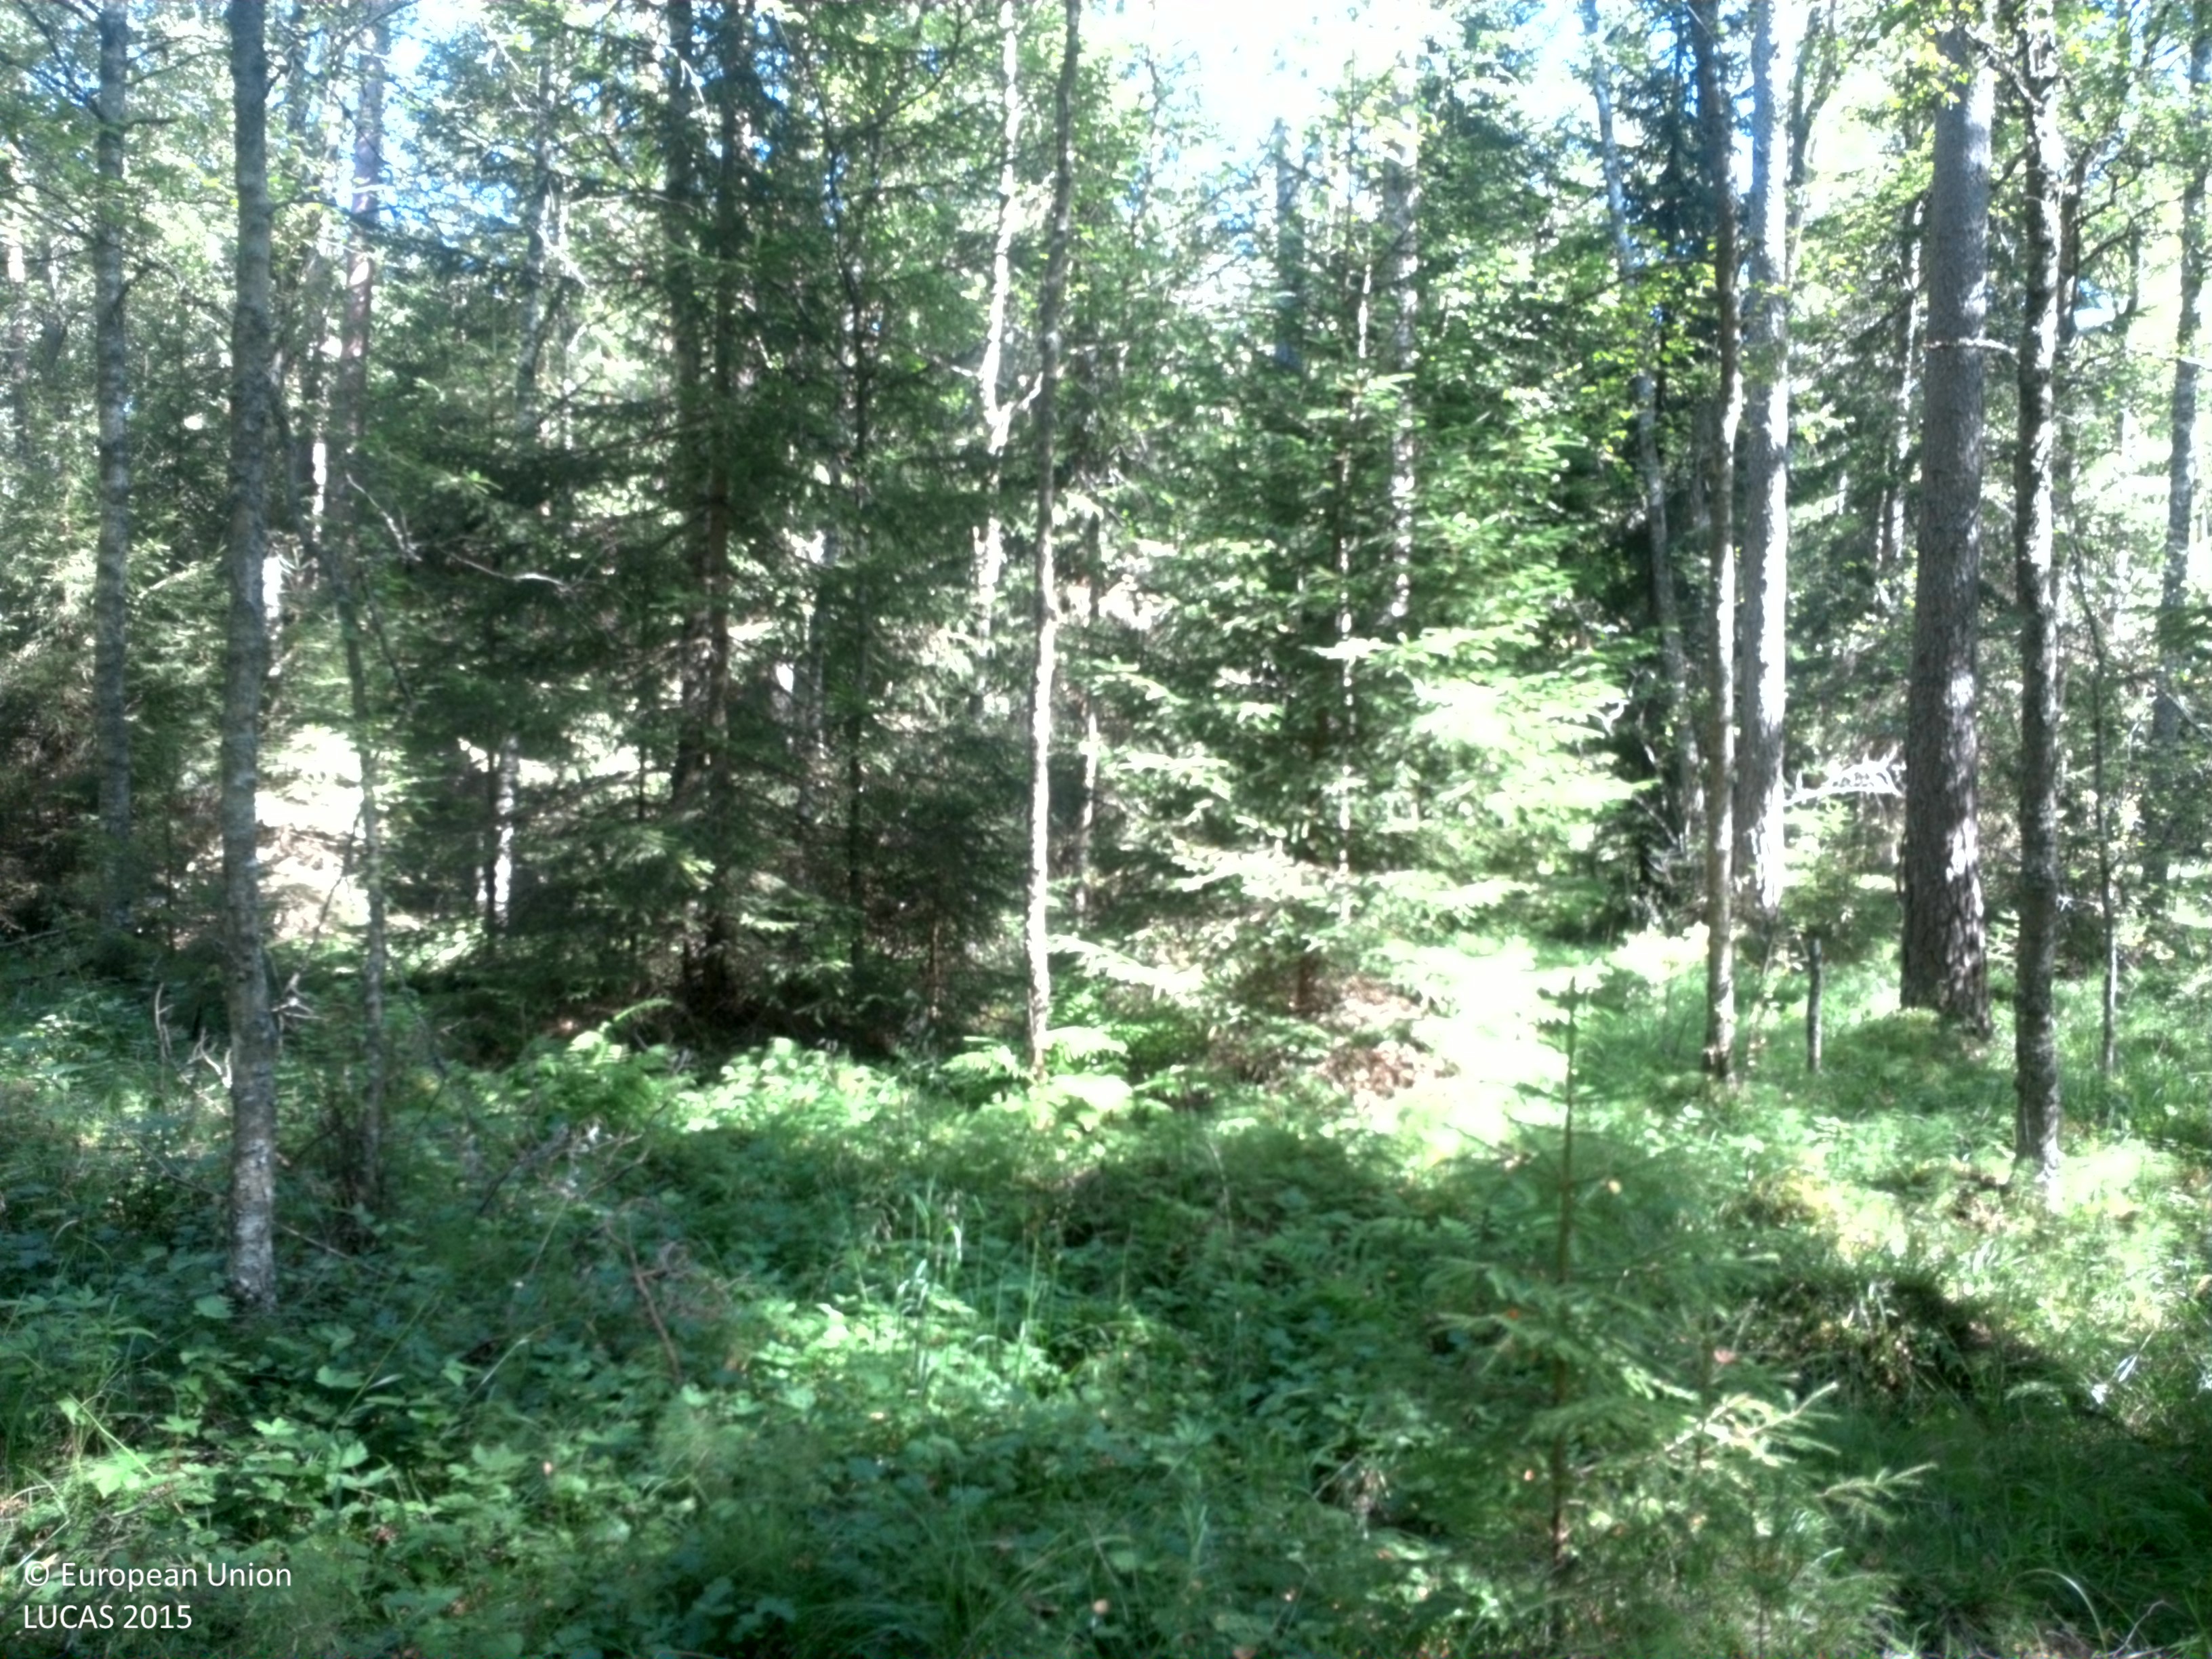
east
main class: Woodland
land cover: Pine dominated mixed woodland
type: boreal forest
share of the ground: 50 - 75 %
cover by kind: coniferous forest trees 30 %, herbaceous plants 25 %, broadleaved forest trees 20 %, lichens and mosses 15 %, shrubs 10 %
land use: Forestry
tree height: > 5 m
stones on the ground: > 50 %
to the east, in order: Pine dominated mixed woodland; Broadleaved woodland; Rivers and streams; Broadleaved woodland; Spruce dominated mixed woodland; Broadleaved woodland; Spruce dominated coniferous woodland
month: August
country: SE
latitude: 58.0718
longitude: 13.2668
